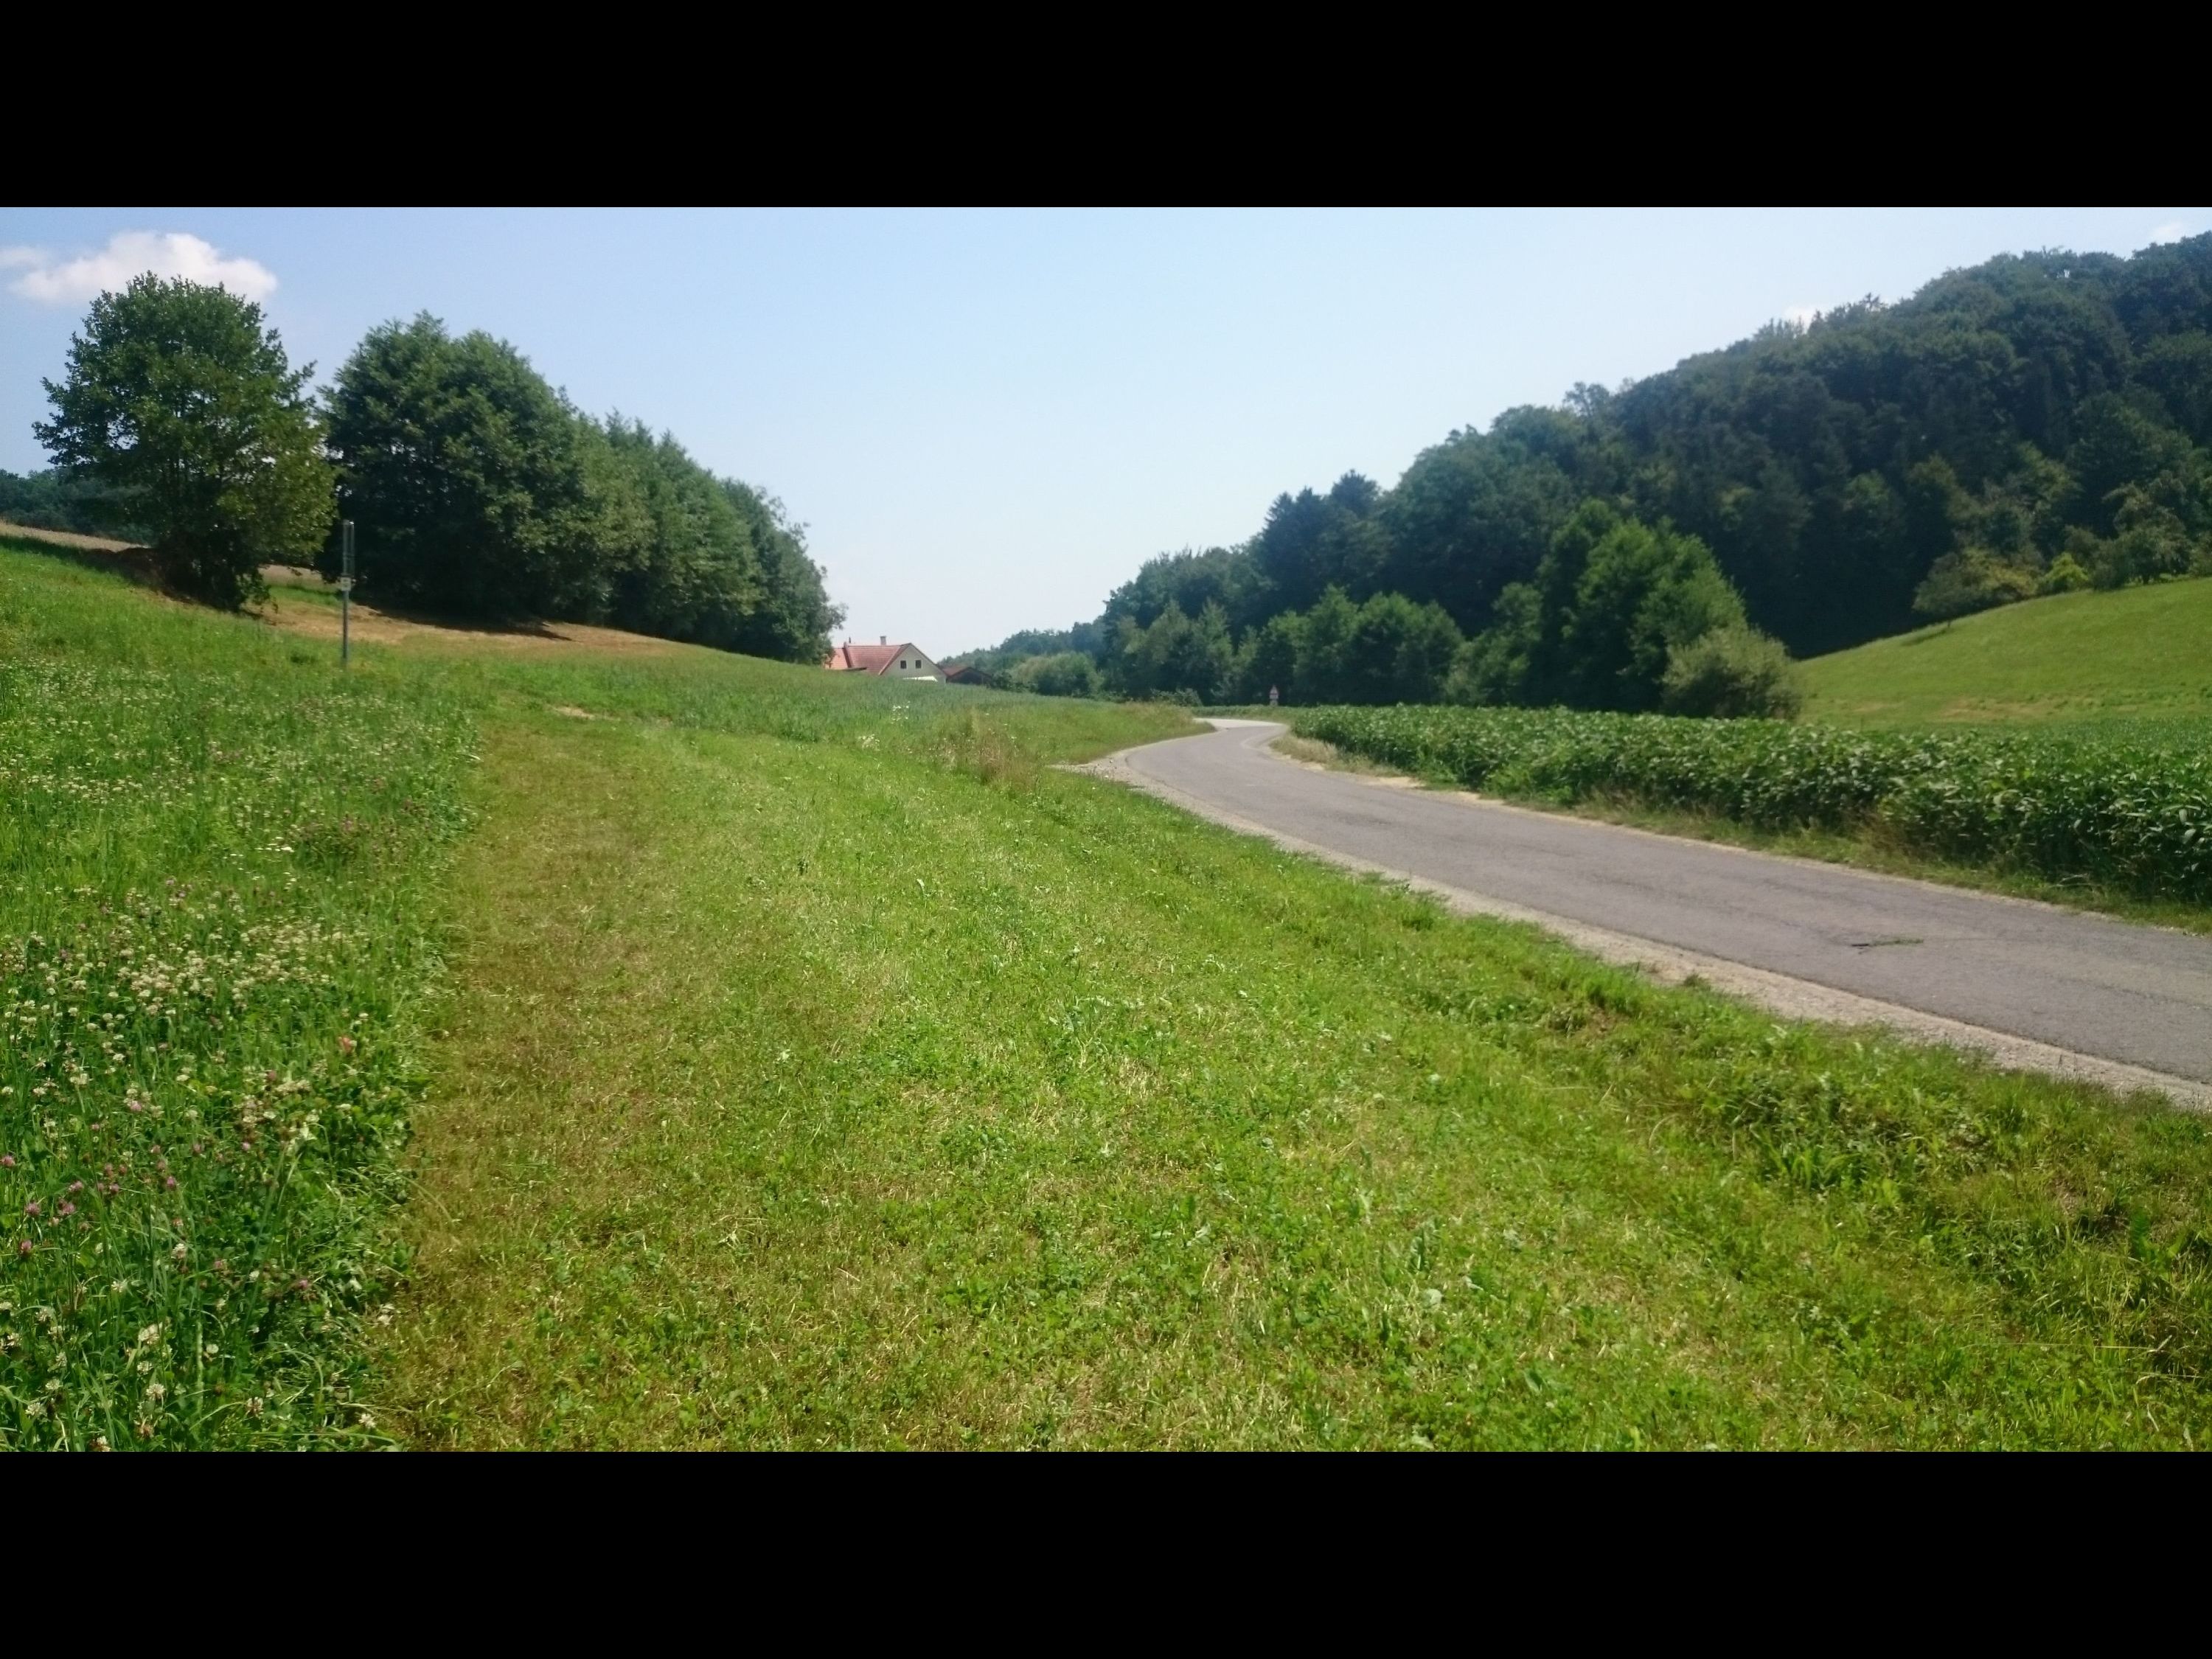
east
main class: Cropland
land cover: Clovers
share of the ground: > 75 %
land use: Agriculture (excluding fallow land and kitchen gardens)
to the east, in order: Clovers; Grass margins; Tracks; Grass margins; Oats; Abandoned hedges; Grassland without tree/shrub cover; Common wheat; Grassland with sparse tree/shrub cover; Maize; Grassland without tree/shrub cover
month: July
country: AT
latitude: 47.0082
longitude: 16.0912
